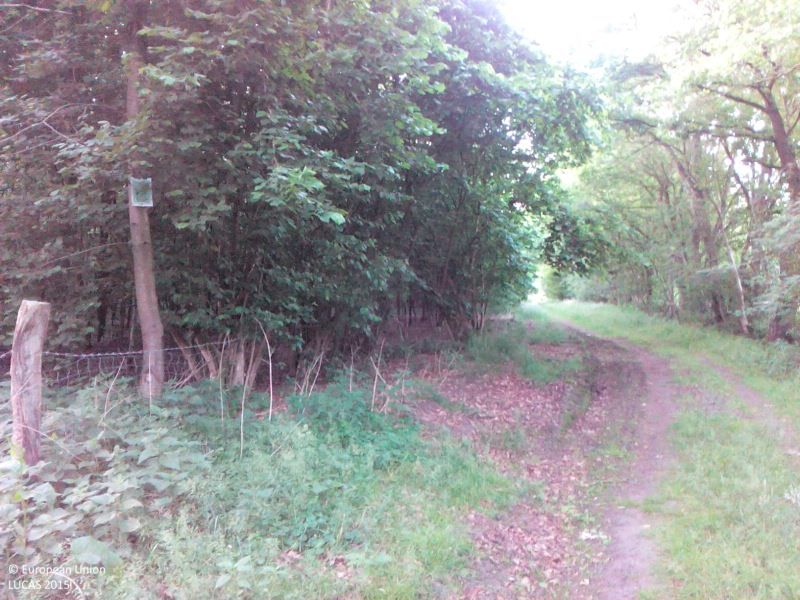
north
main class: Grassland
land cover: Spontaneously vegetated surfaces
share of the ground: > 75 %
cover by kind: herbaceous plants 95 %, shrubs 5 %
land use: Forestry
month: June
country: DE
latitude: 52.5639
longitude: 7.3597
